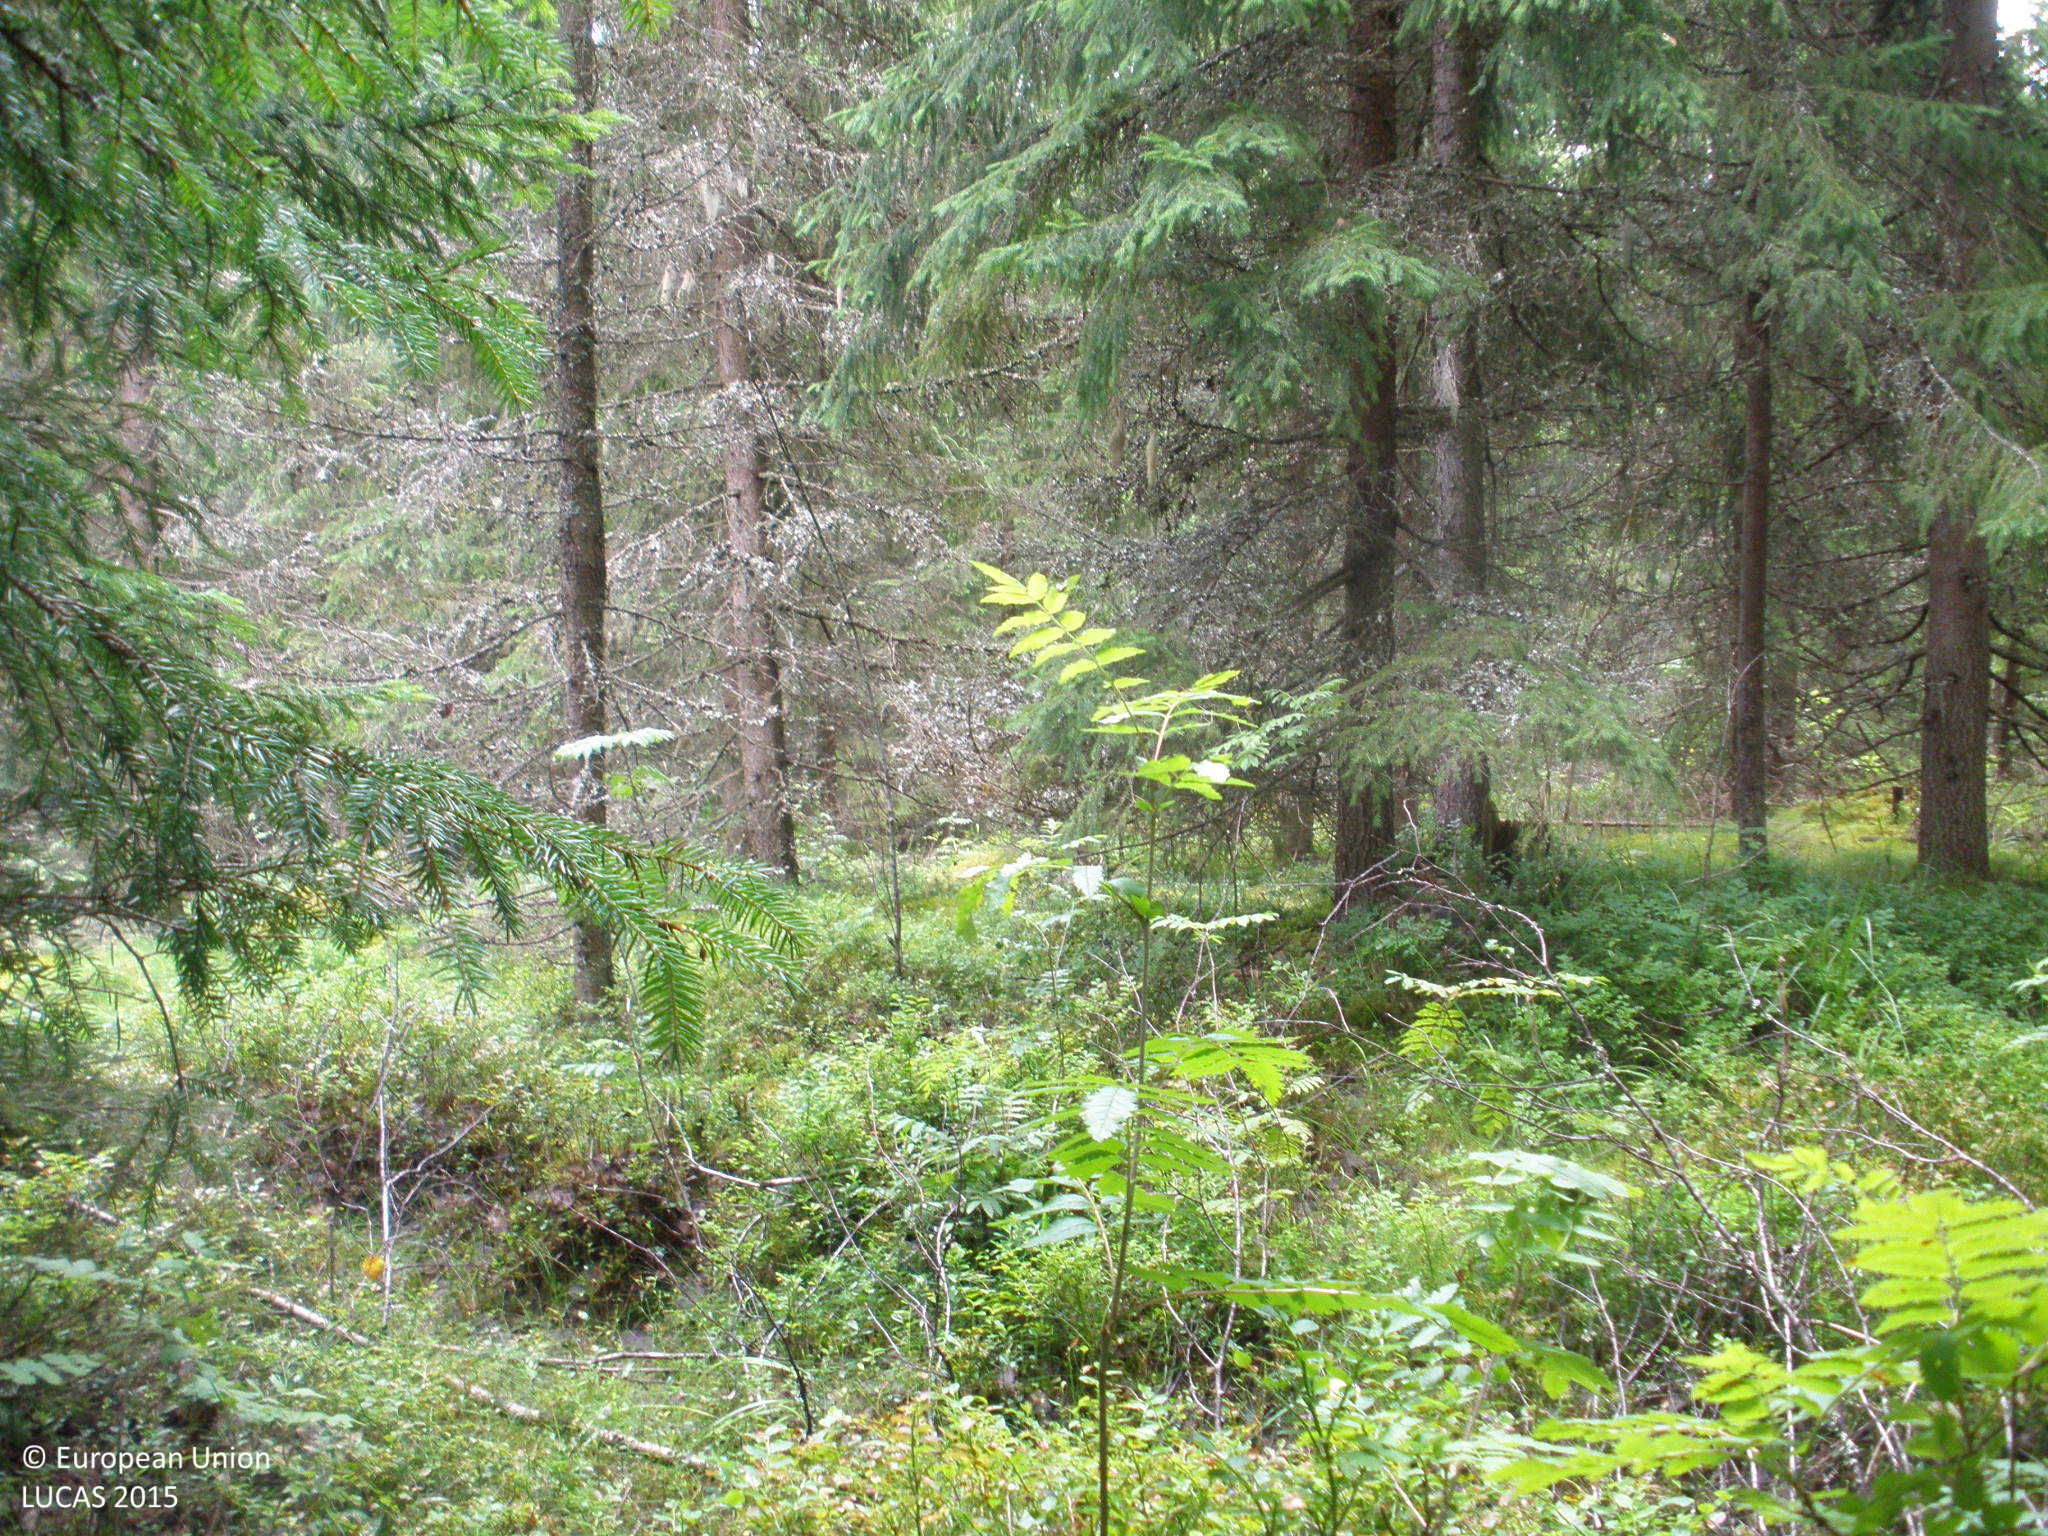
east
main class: Woodland
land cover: Spruce dominated coniferous woodland
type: boreal forest
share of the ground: > 75 %
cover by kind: coniferous forest trees 90 %, herbaceous plants 5 %, lichens and mosses 5 %
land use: Forestry
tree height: > 5 m
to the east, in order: Spruce dominated coniferous woodland; Grassland with sparse tree/shrub cover; Pine dominated mixed woodland; Spruce dominated mixed woodland; Ditches and canals; Grass margins; Tracks; Grass margins; Spruce dominated mixed woodland
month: July
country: FI
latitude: 60.9475
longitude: 25.0495
